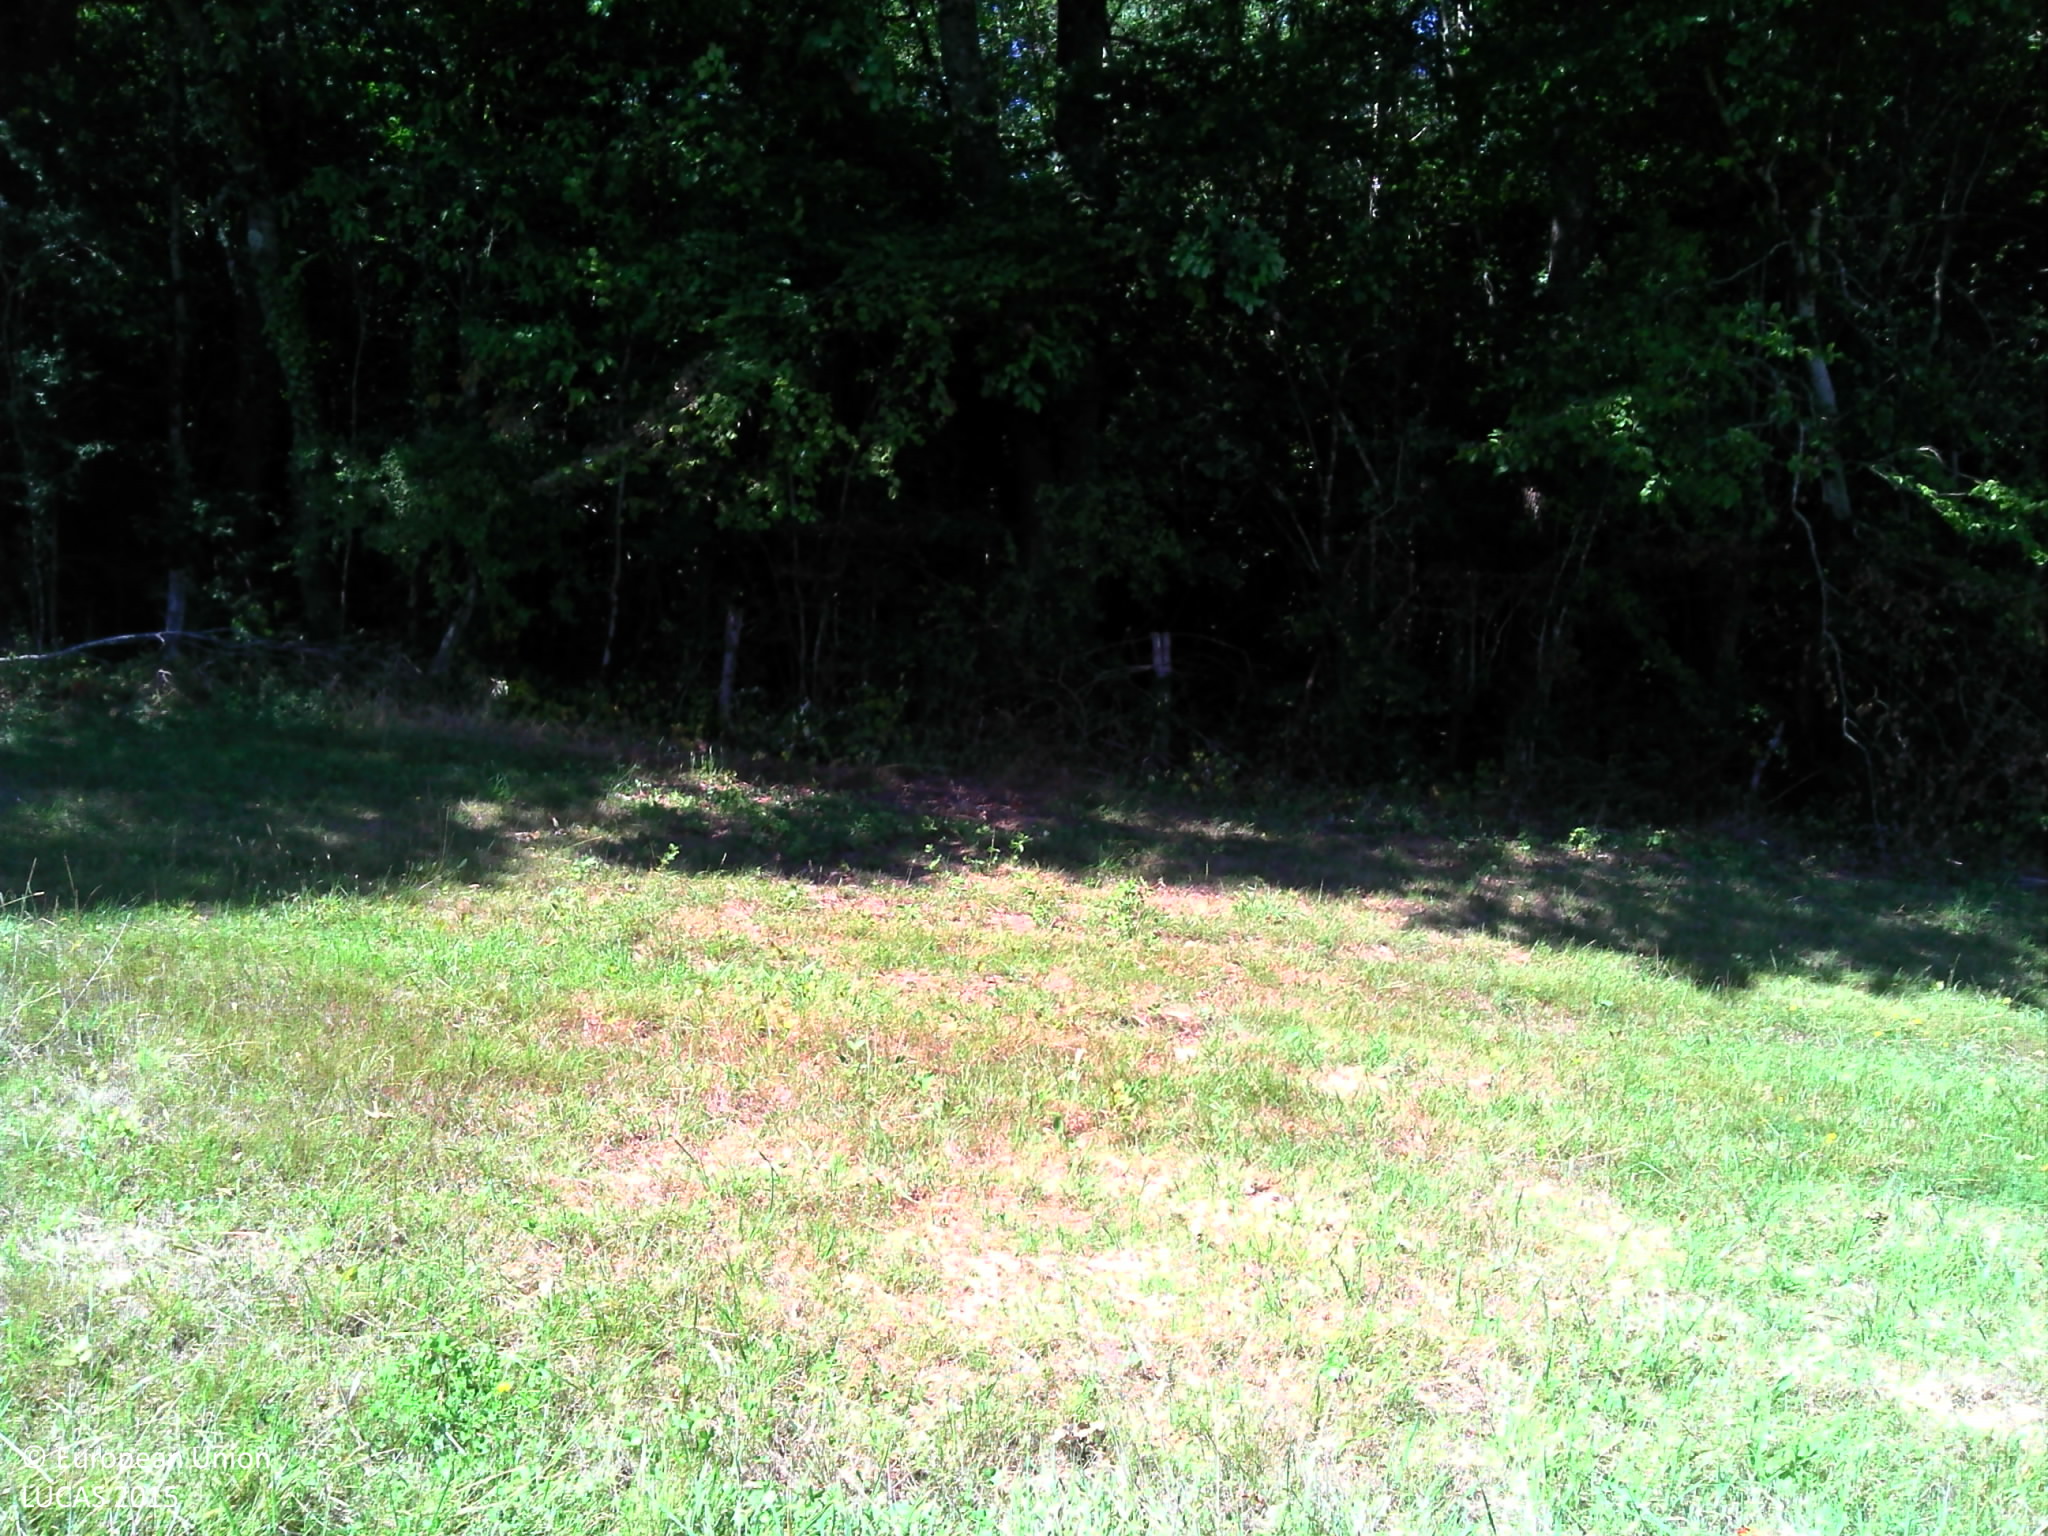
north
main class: Grassland
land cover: Grassland without tree/shrub cover
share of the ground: > 75 %
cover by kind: herbaceous plants 100 %
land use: Agriculture (excluding fallow land and kitchen gardens)
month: June
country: FR
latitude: 47.5091
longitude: 6.1908
